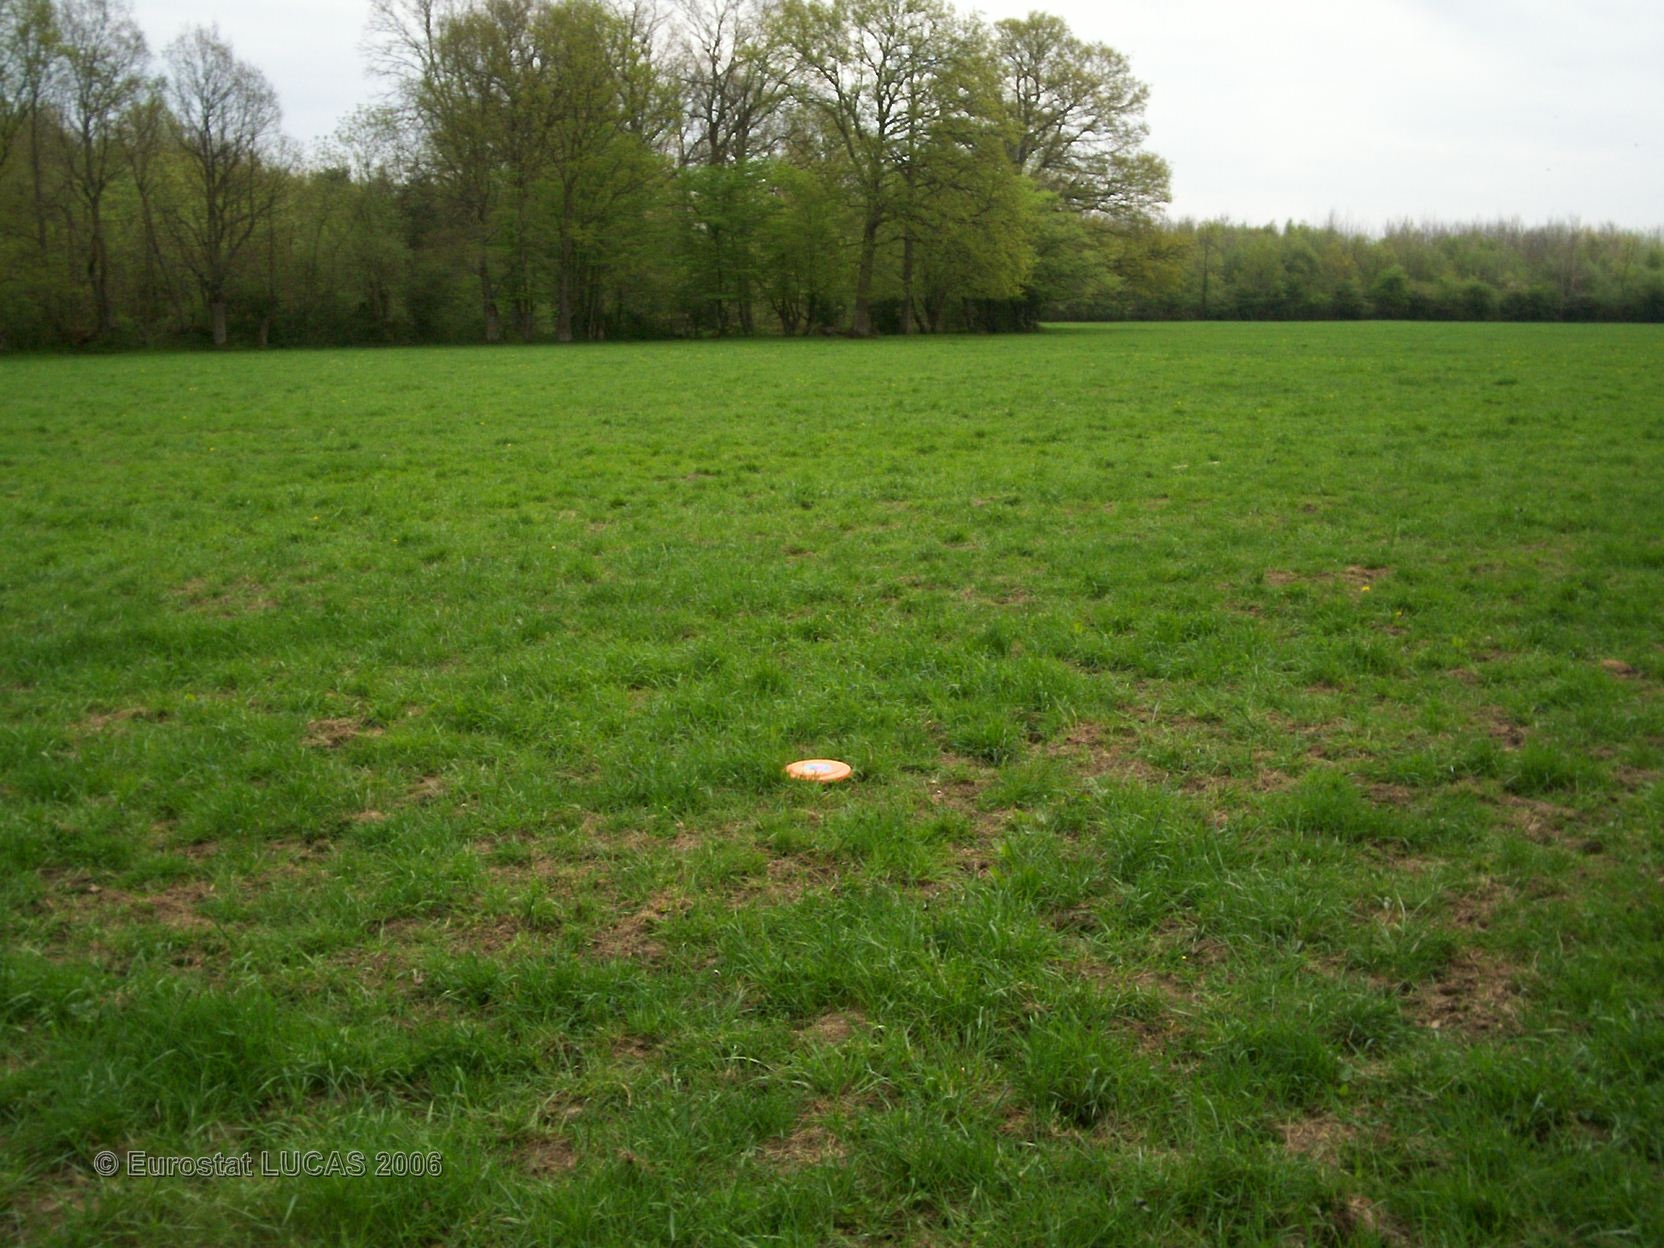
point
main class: Grassland
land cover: Grassland without tree/shrub cover
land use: Agriculture (excluding fallow land and kitchen gardens)
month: May
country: FR
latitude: 48.9034
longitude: 0.5478
